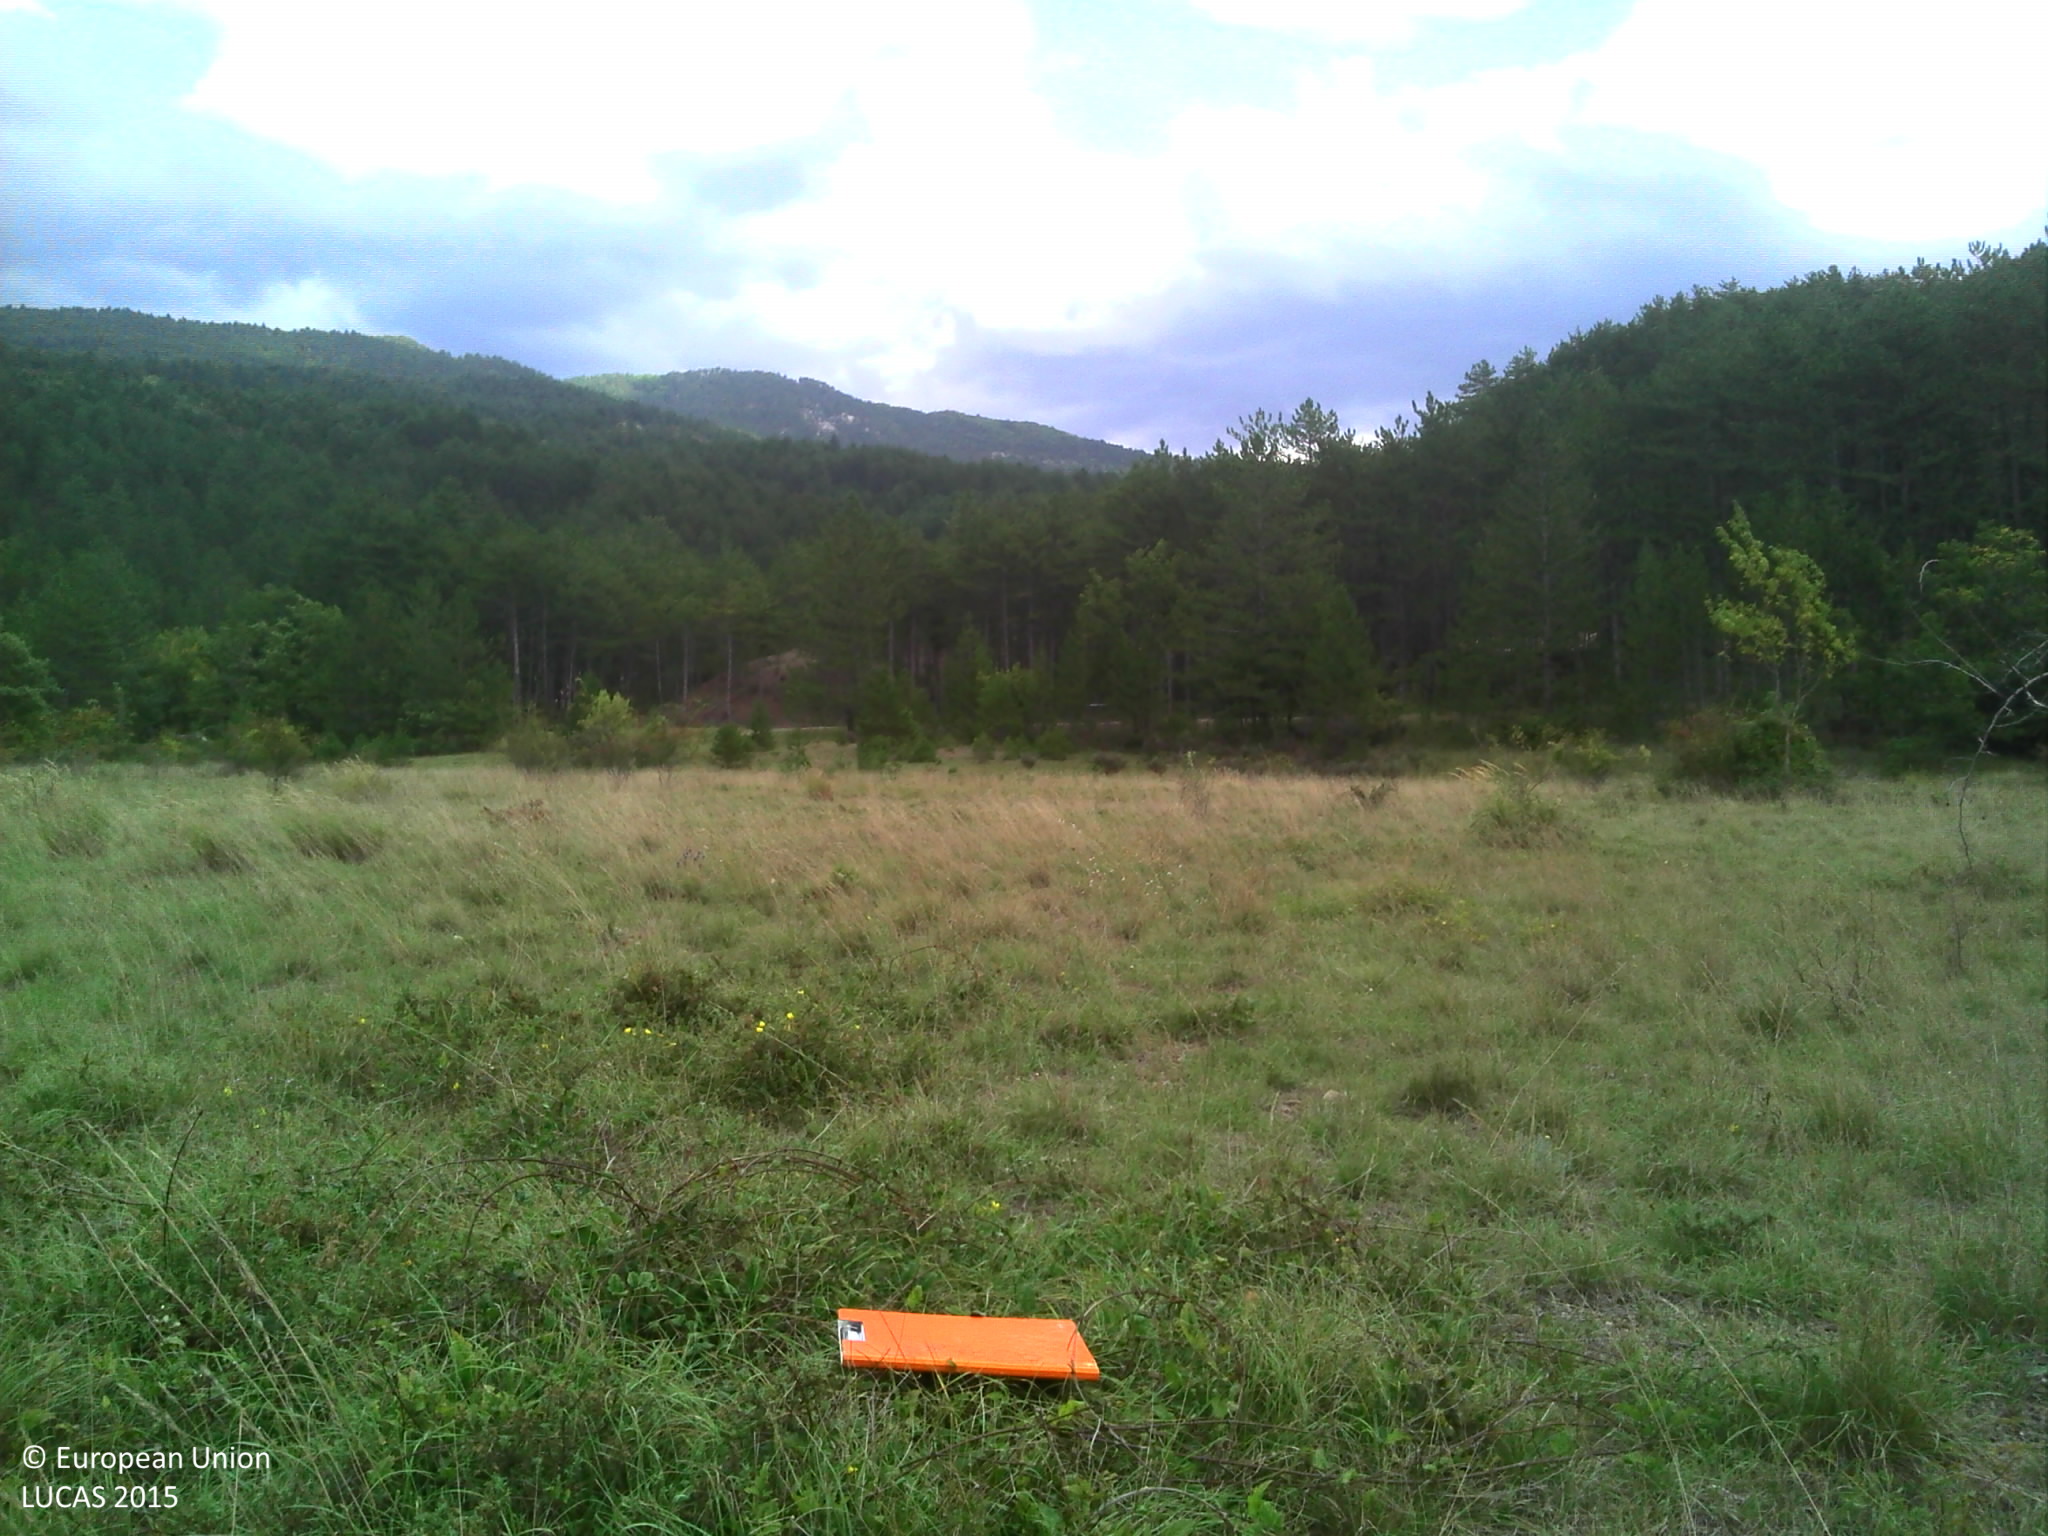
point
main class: Grassland
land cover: Grassland without tree/shrub cover
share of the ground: > 75 %
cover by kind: herbaceous plants 95 %, shrubs 5 %
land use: Agriculture (excluding fallow land and kitchen gardens)
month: September
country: FR
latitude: 44.4460
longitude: 5.3705
